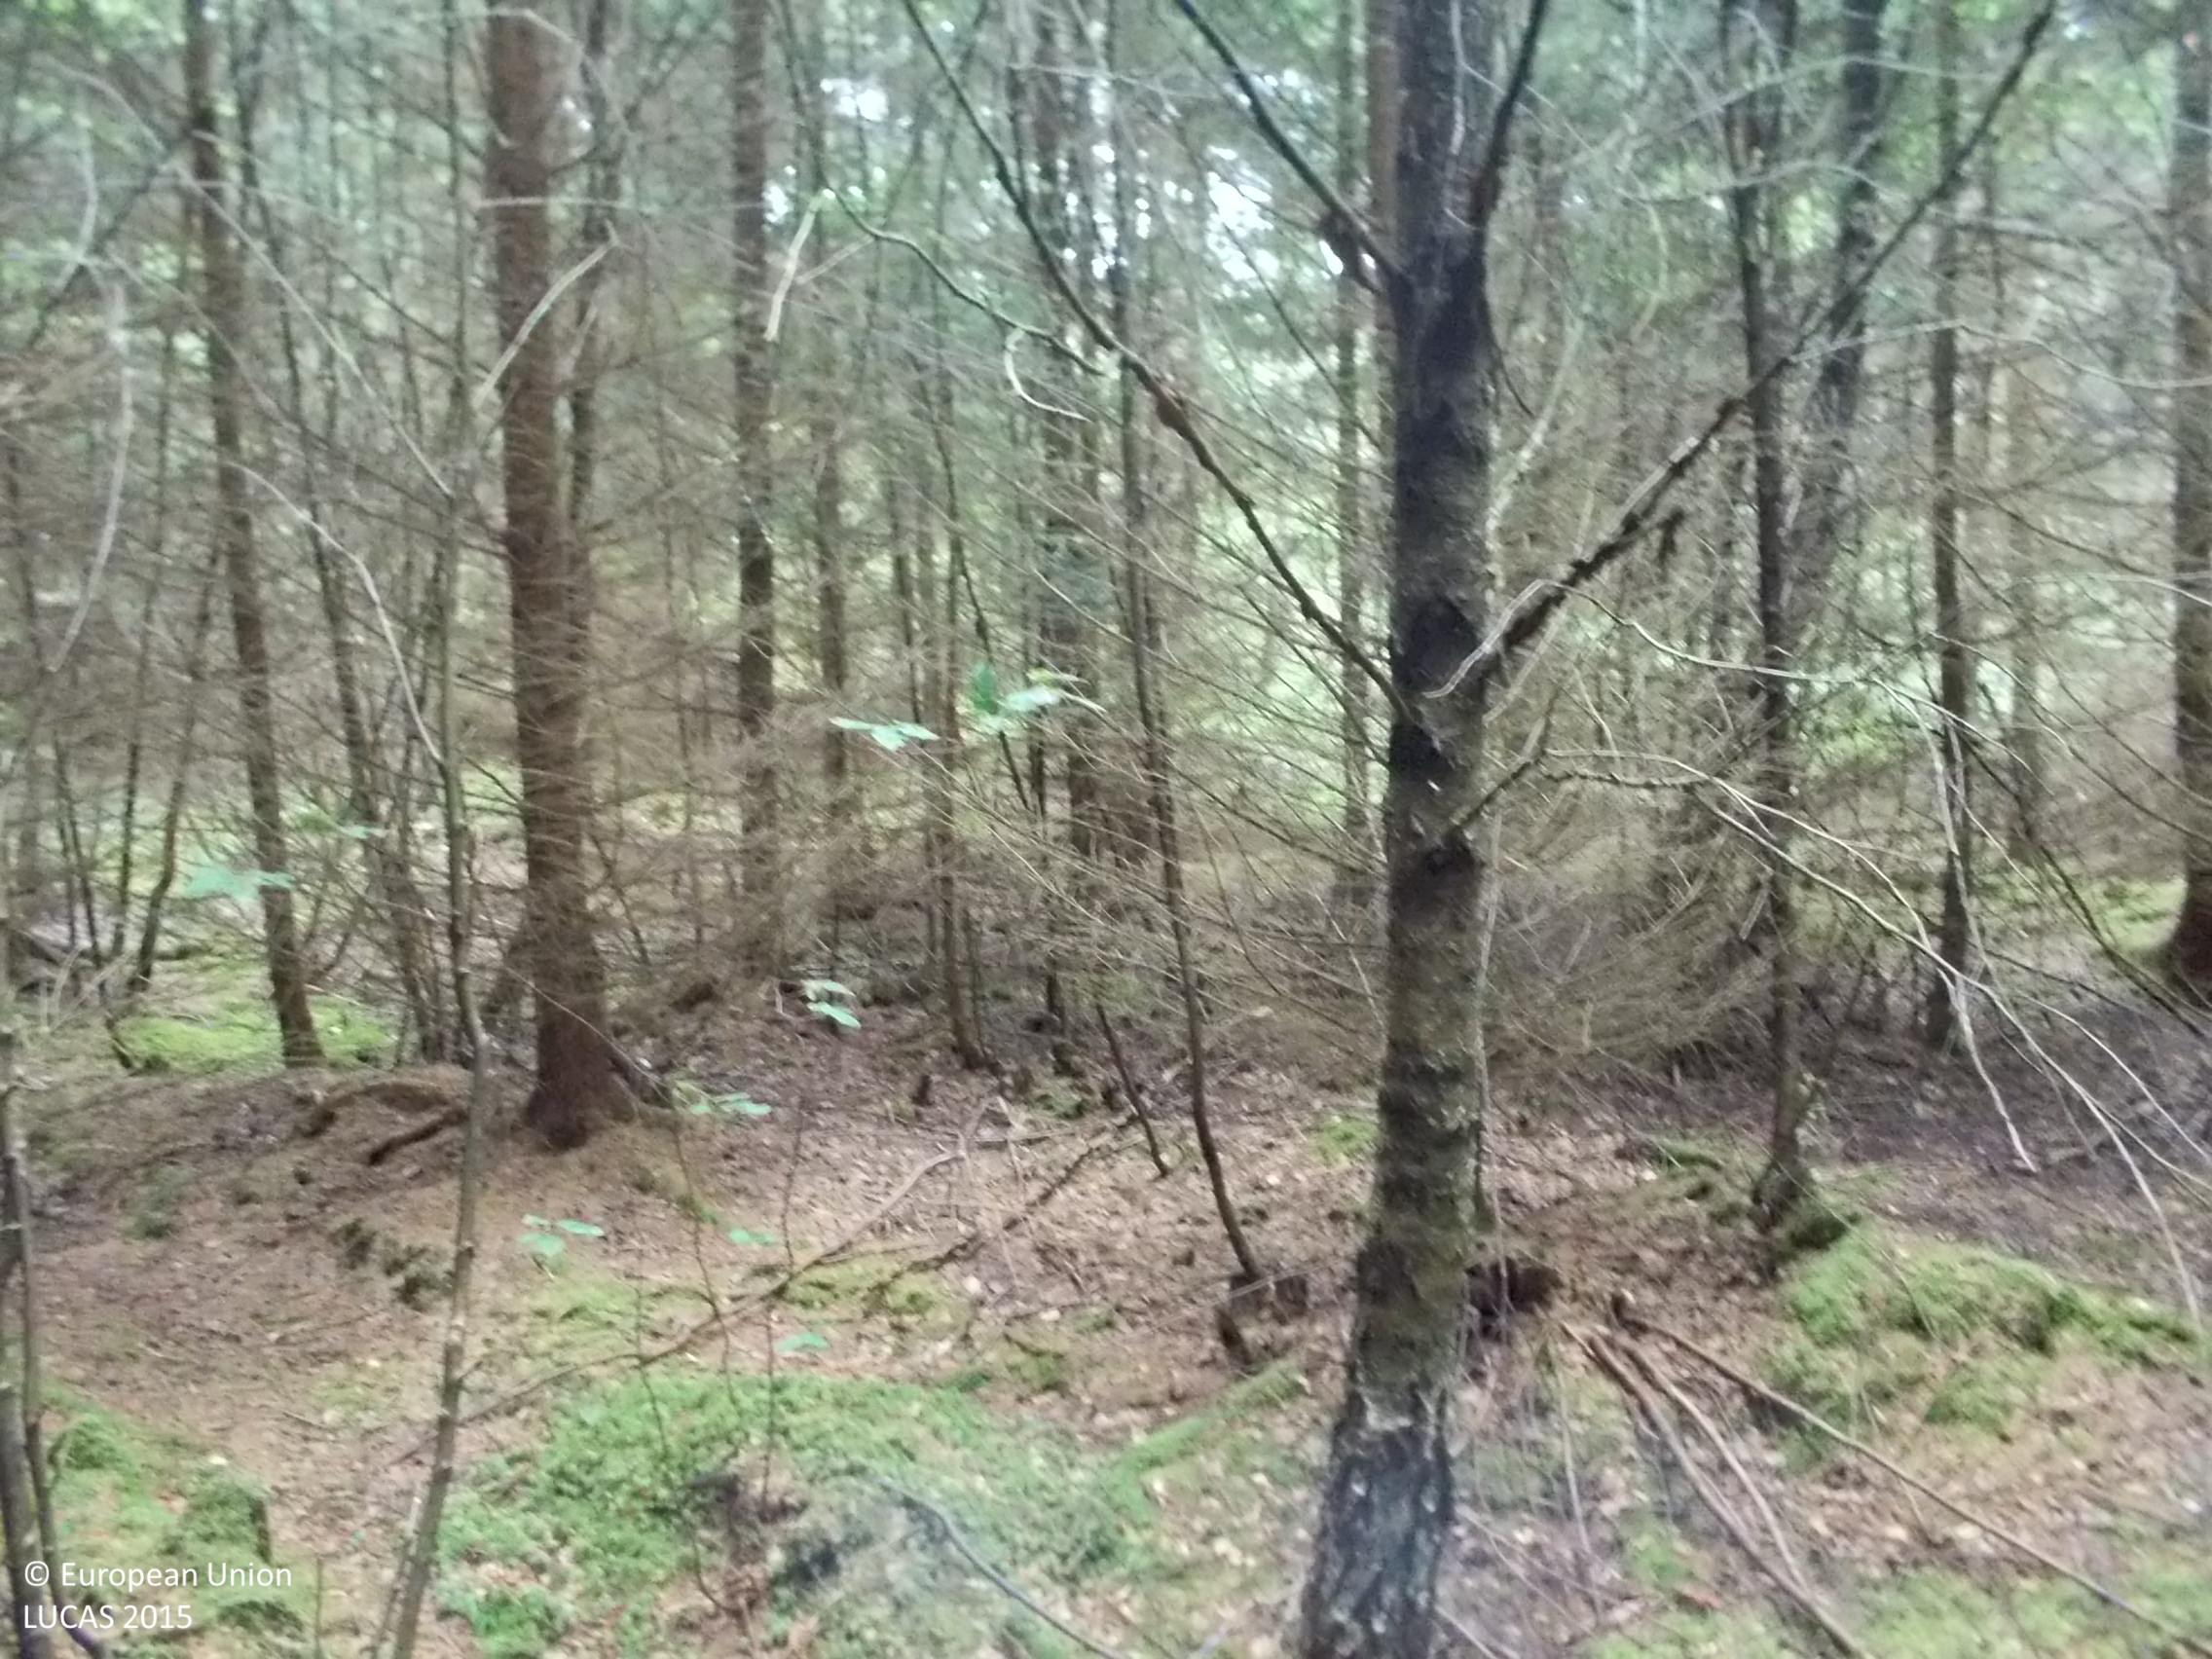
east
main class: Woodland
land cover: Spruce dominated coniferous woodland
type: boreal forest
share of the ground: > 75 %
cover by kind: coniferous forest trees 95 %, lichens and mosses 5 %
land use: Forestry
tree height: > 5 m
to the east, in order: Spruce dominated coniferous woodland; Broadleaved woodland; Tracks; Pine dominated mixed woodland; Spruce dominated mixed woodland; Other coniferous woodland; Pine dominated mixed woodland
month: July
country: SE
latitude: 57.3193
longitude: 12.2384
